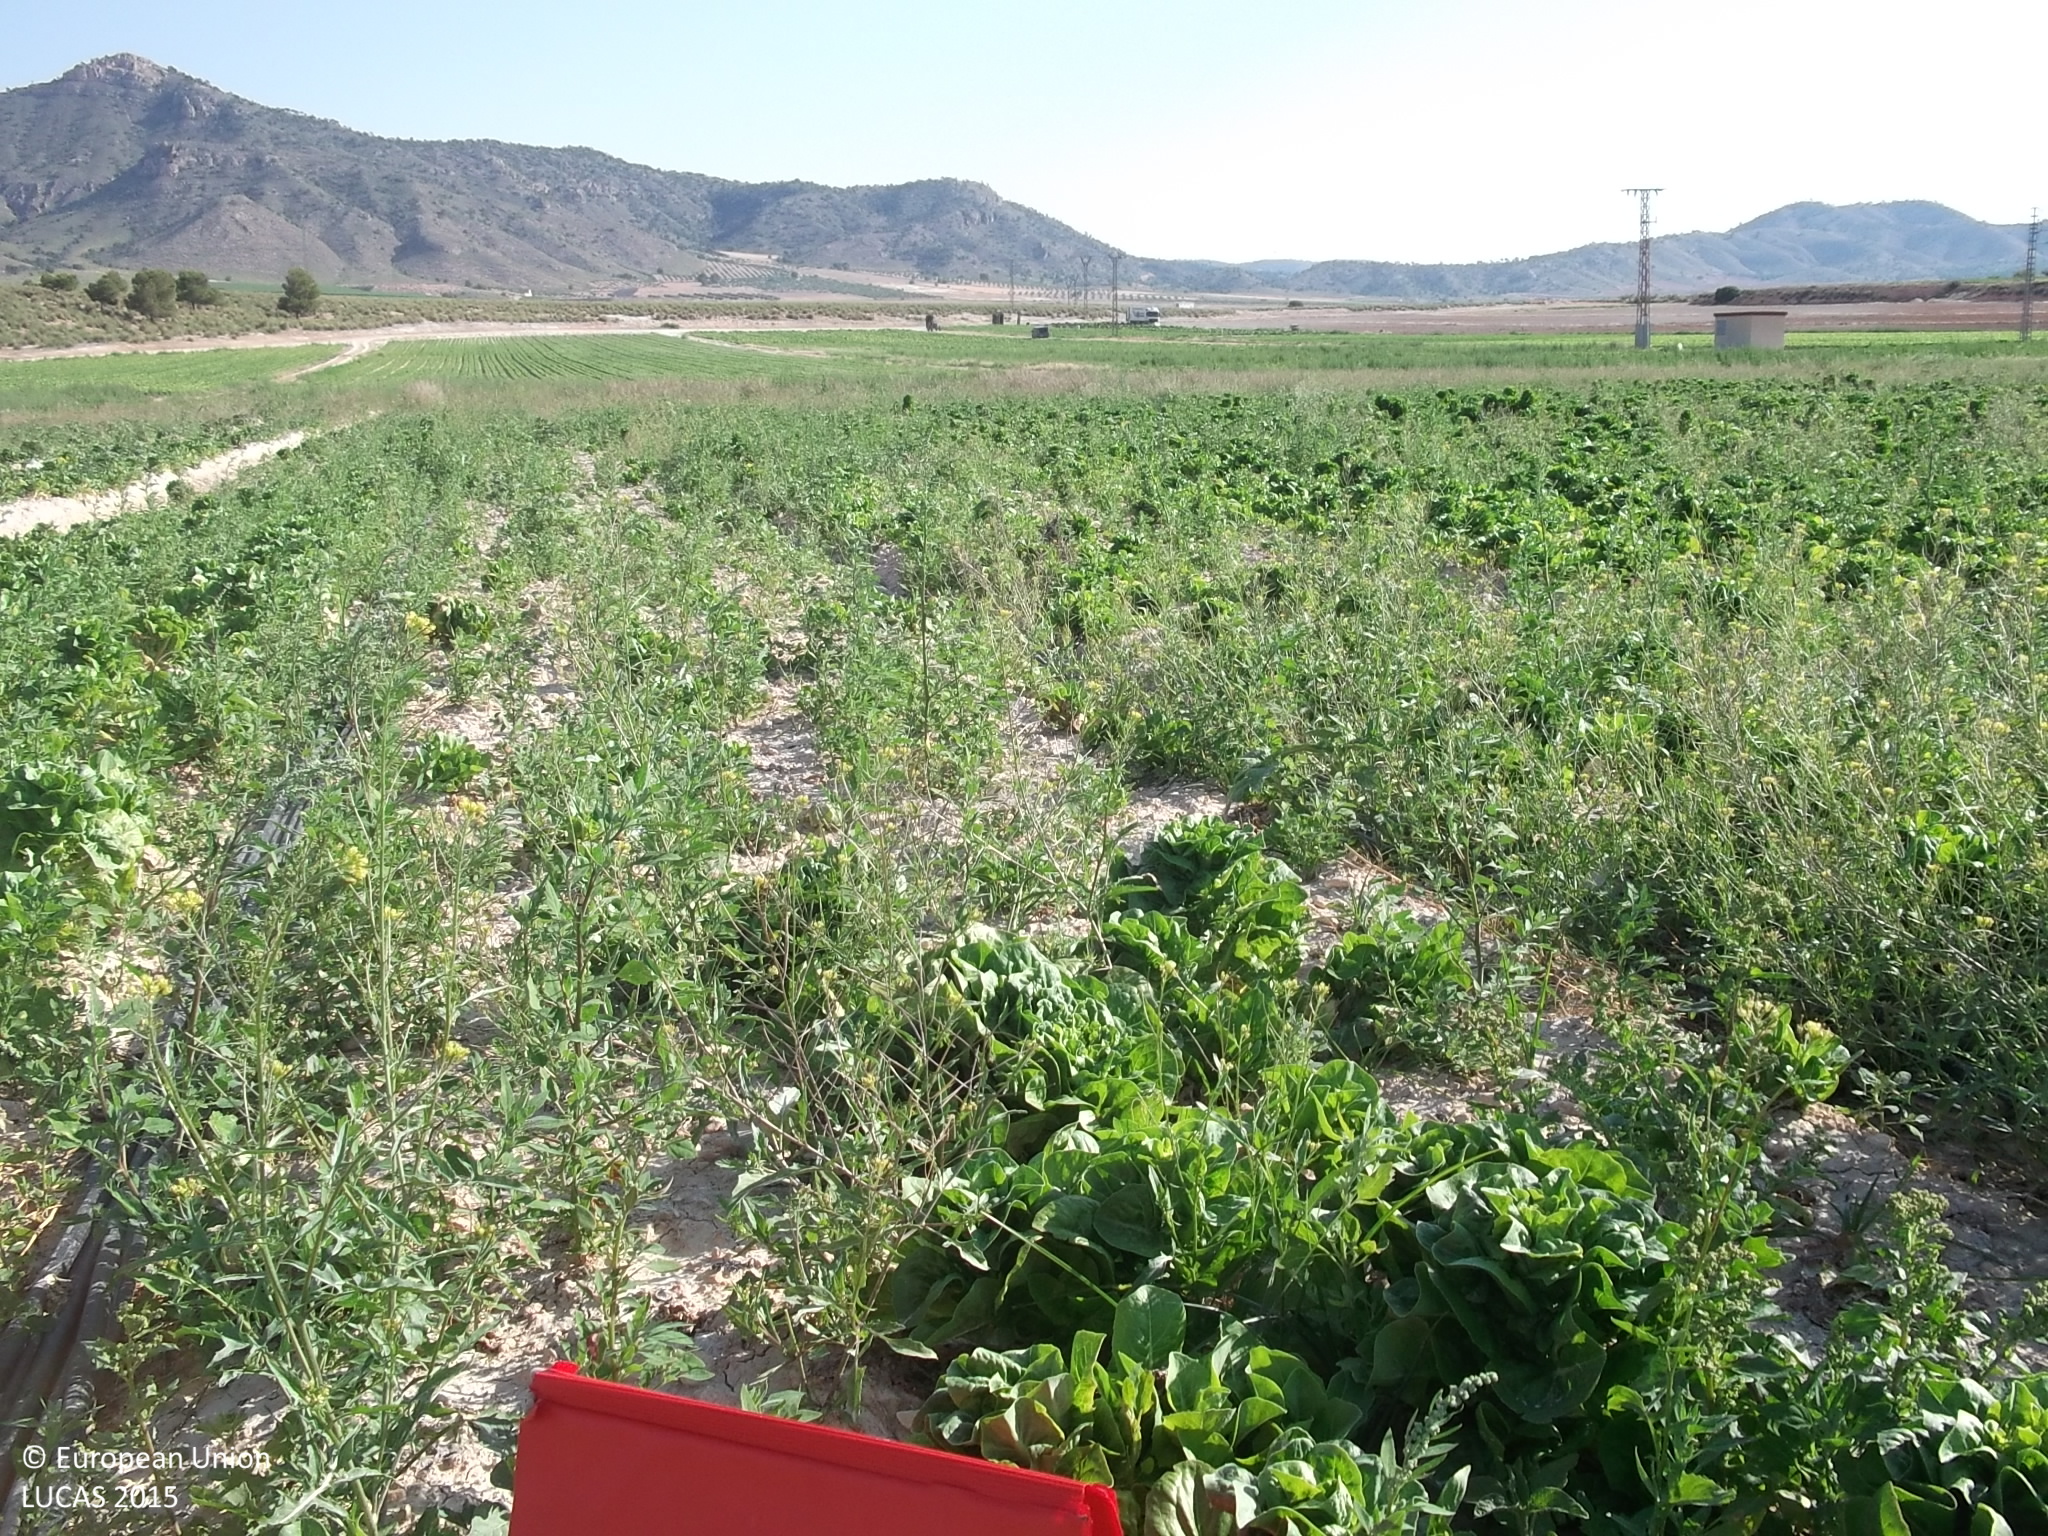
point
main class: Cropland
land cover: Other fresh vegetables
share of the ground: > 75 %
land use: Agriculture (excluding fallow land and kitchen gardens)
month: June
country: ES
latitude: 38.4040
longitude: -1.4762
